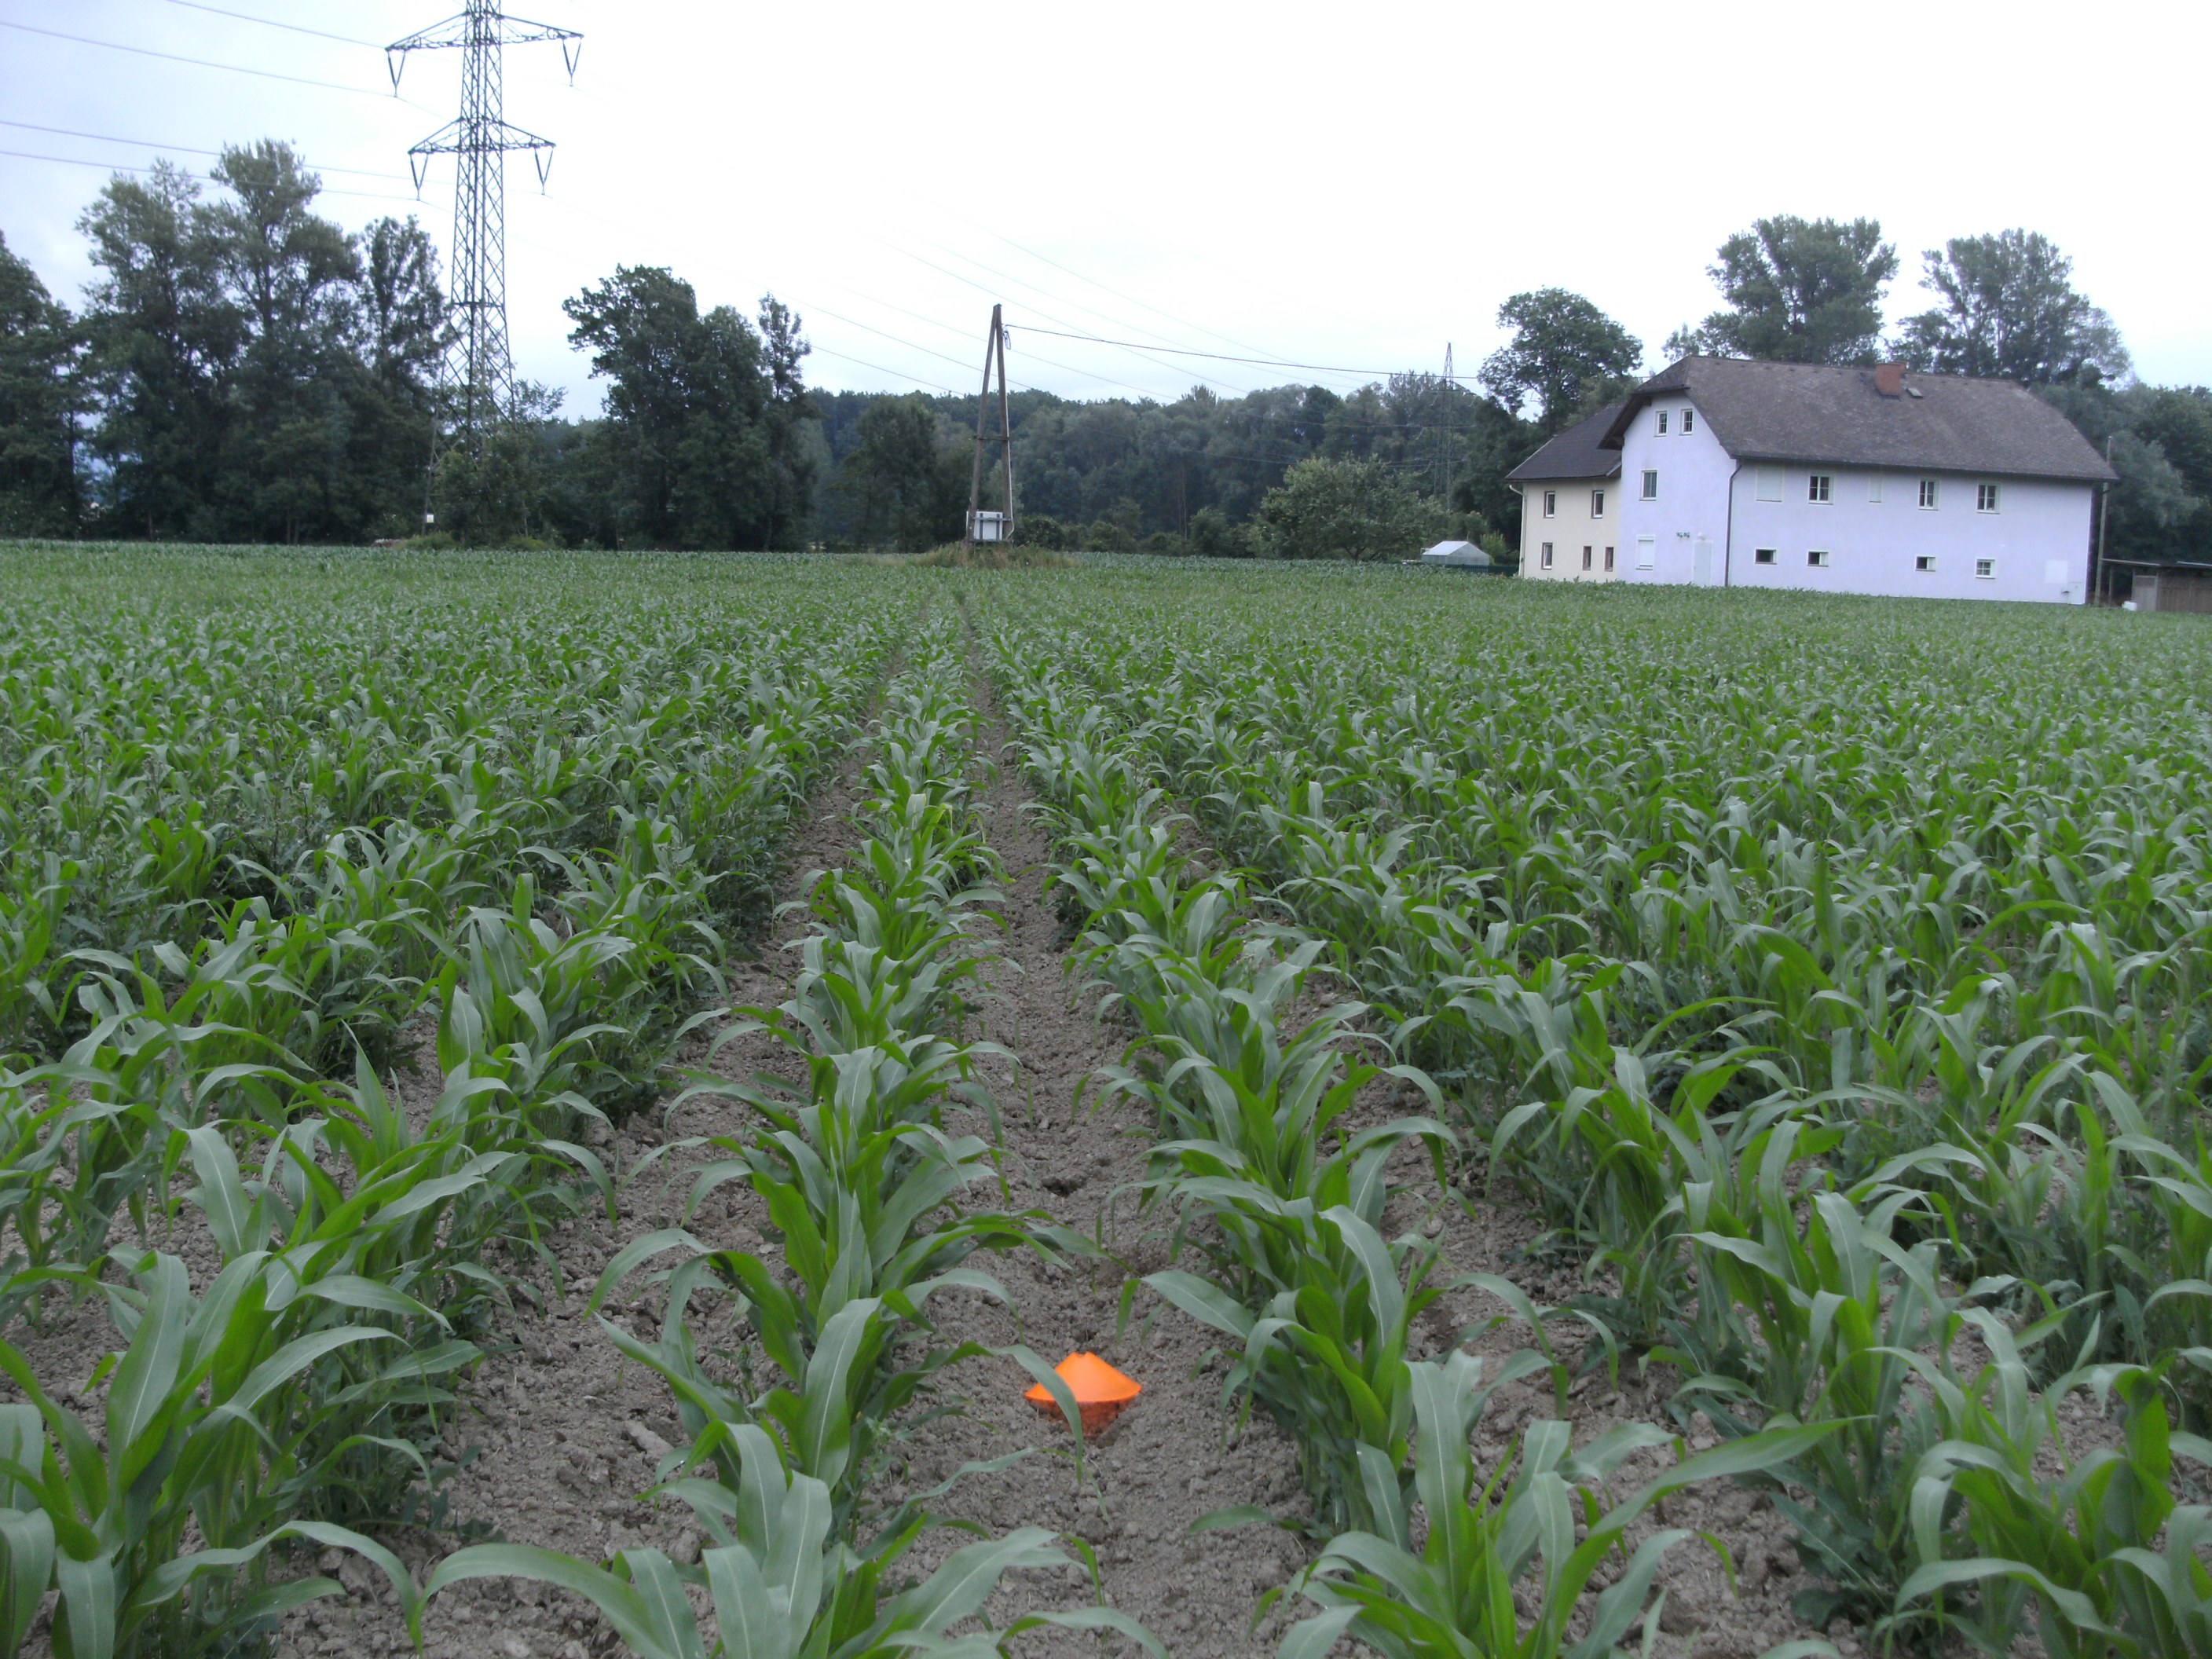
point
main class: Cropland
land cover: Maize
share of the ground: 50 - 75 %
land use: Agriculture (excluding fallow land and kitchen gardens)
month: June
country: AT
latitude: 48.3270
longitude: 14.1138
